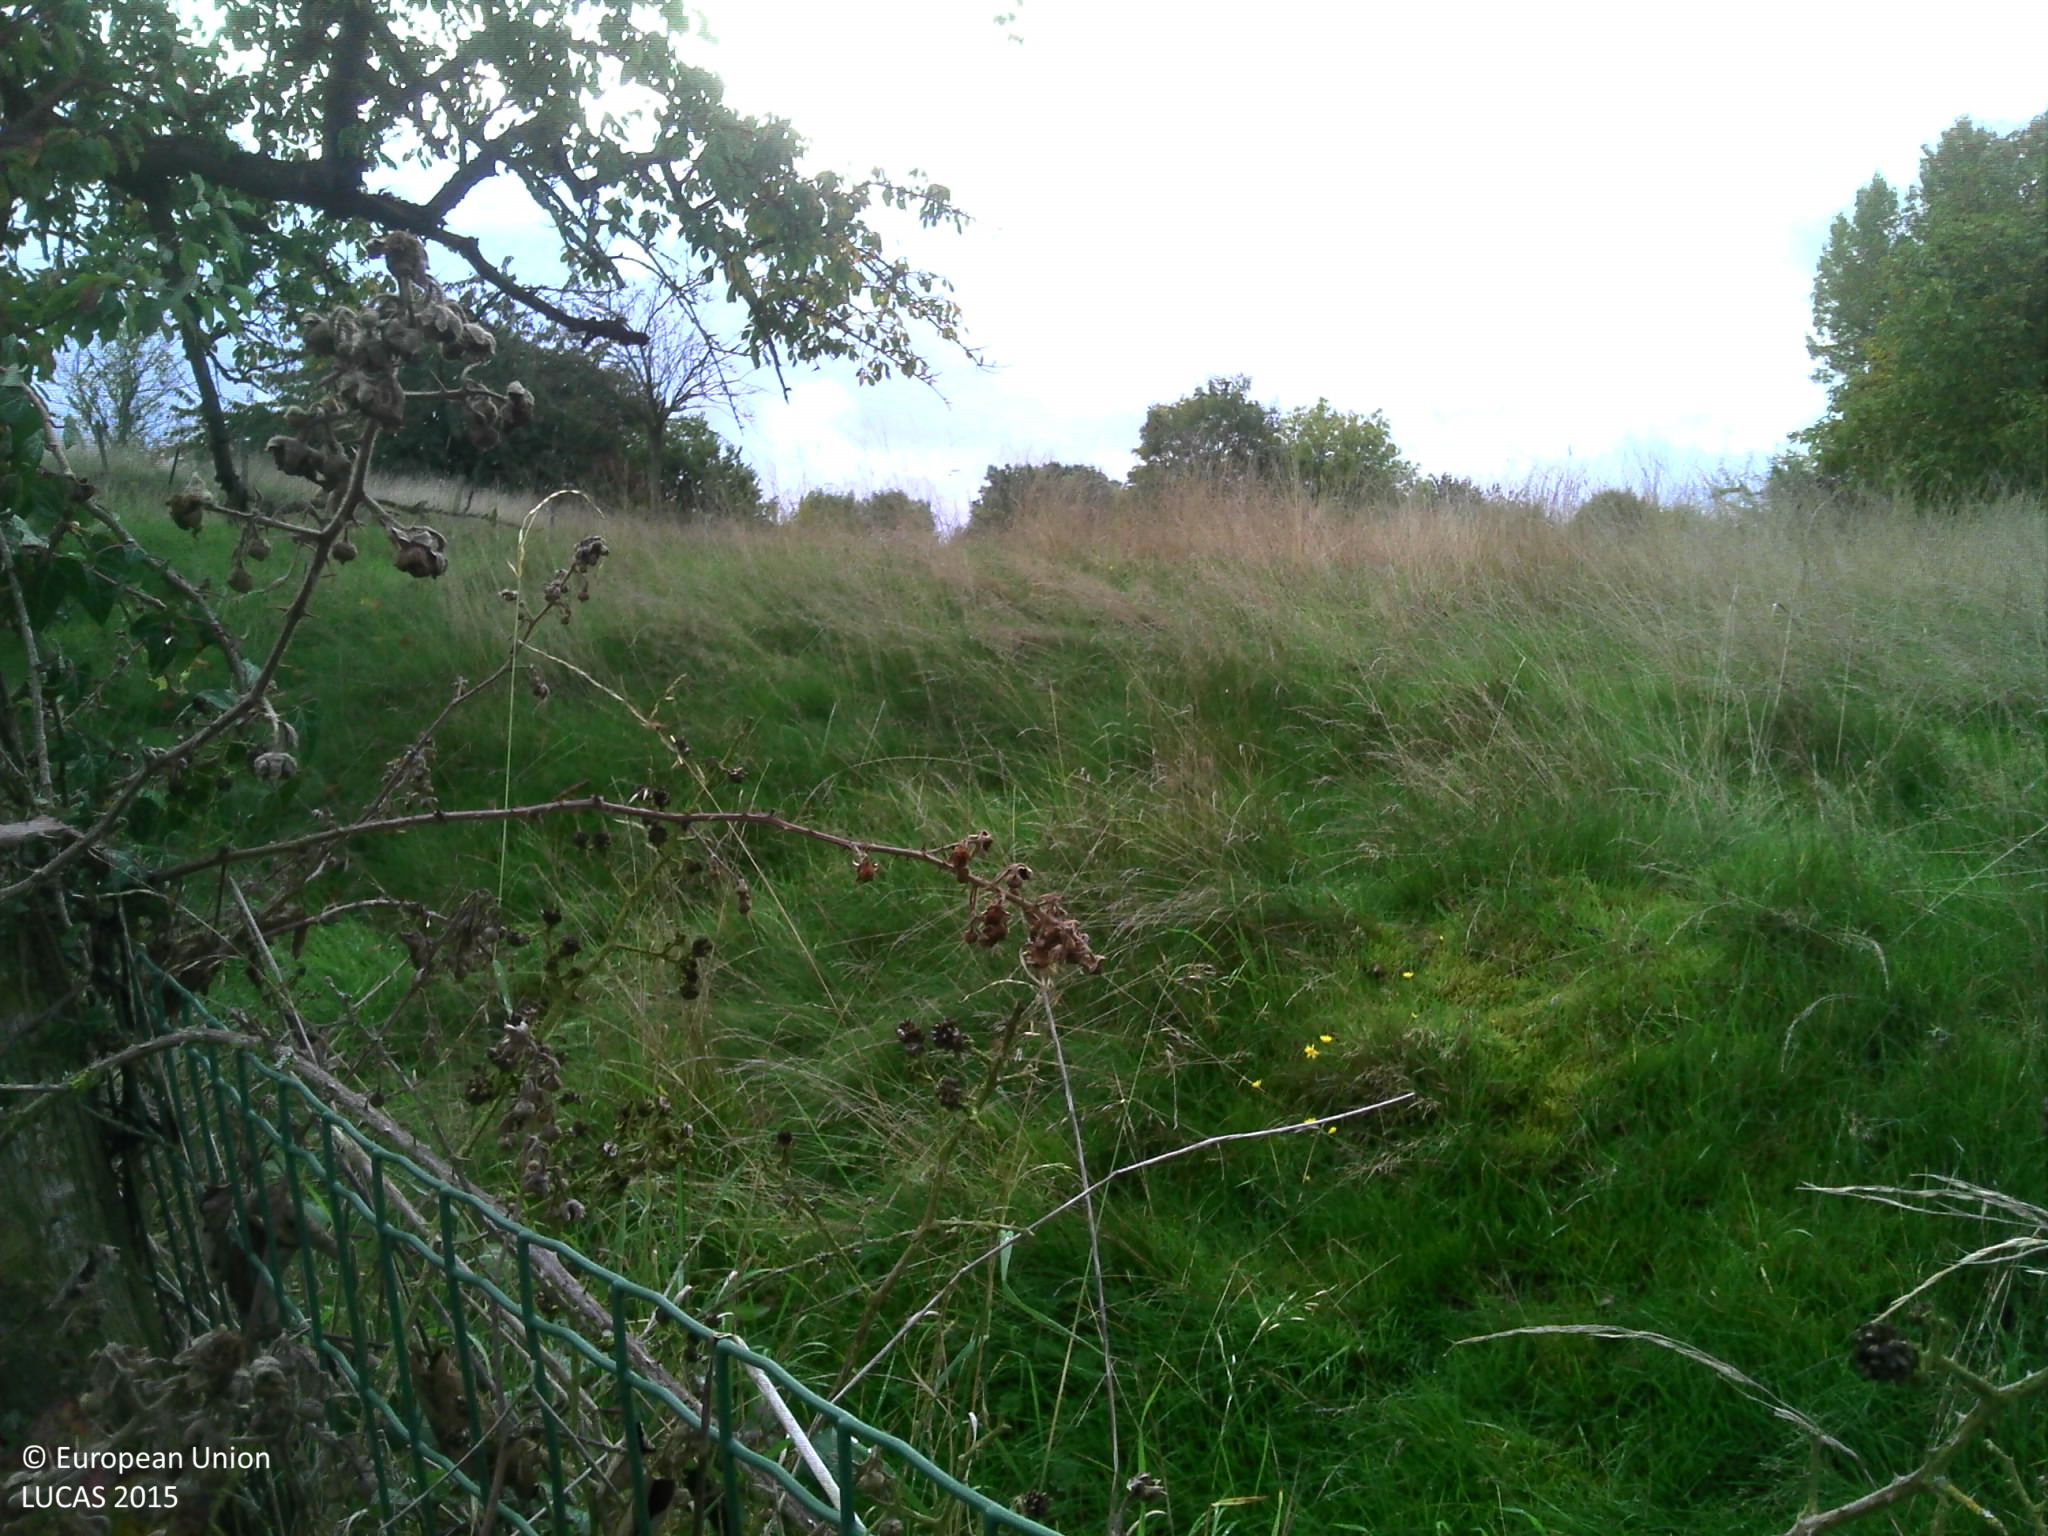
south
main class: Grassland
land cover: Grassland without tree/shrub cover
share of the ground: > 75 %
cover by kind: herbaceous plants 100 %
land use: Agriculture (excluding fallow land and kitchen gardens)
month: October
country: BE
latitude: 50.8235
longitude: 4.0748
